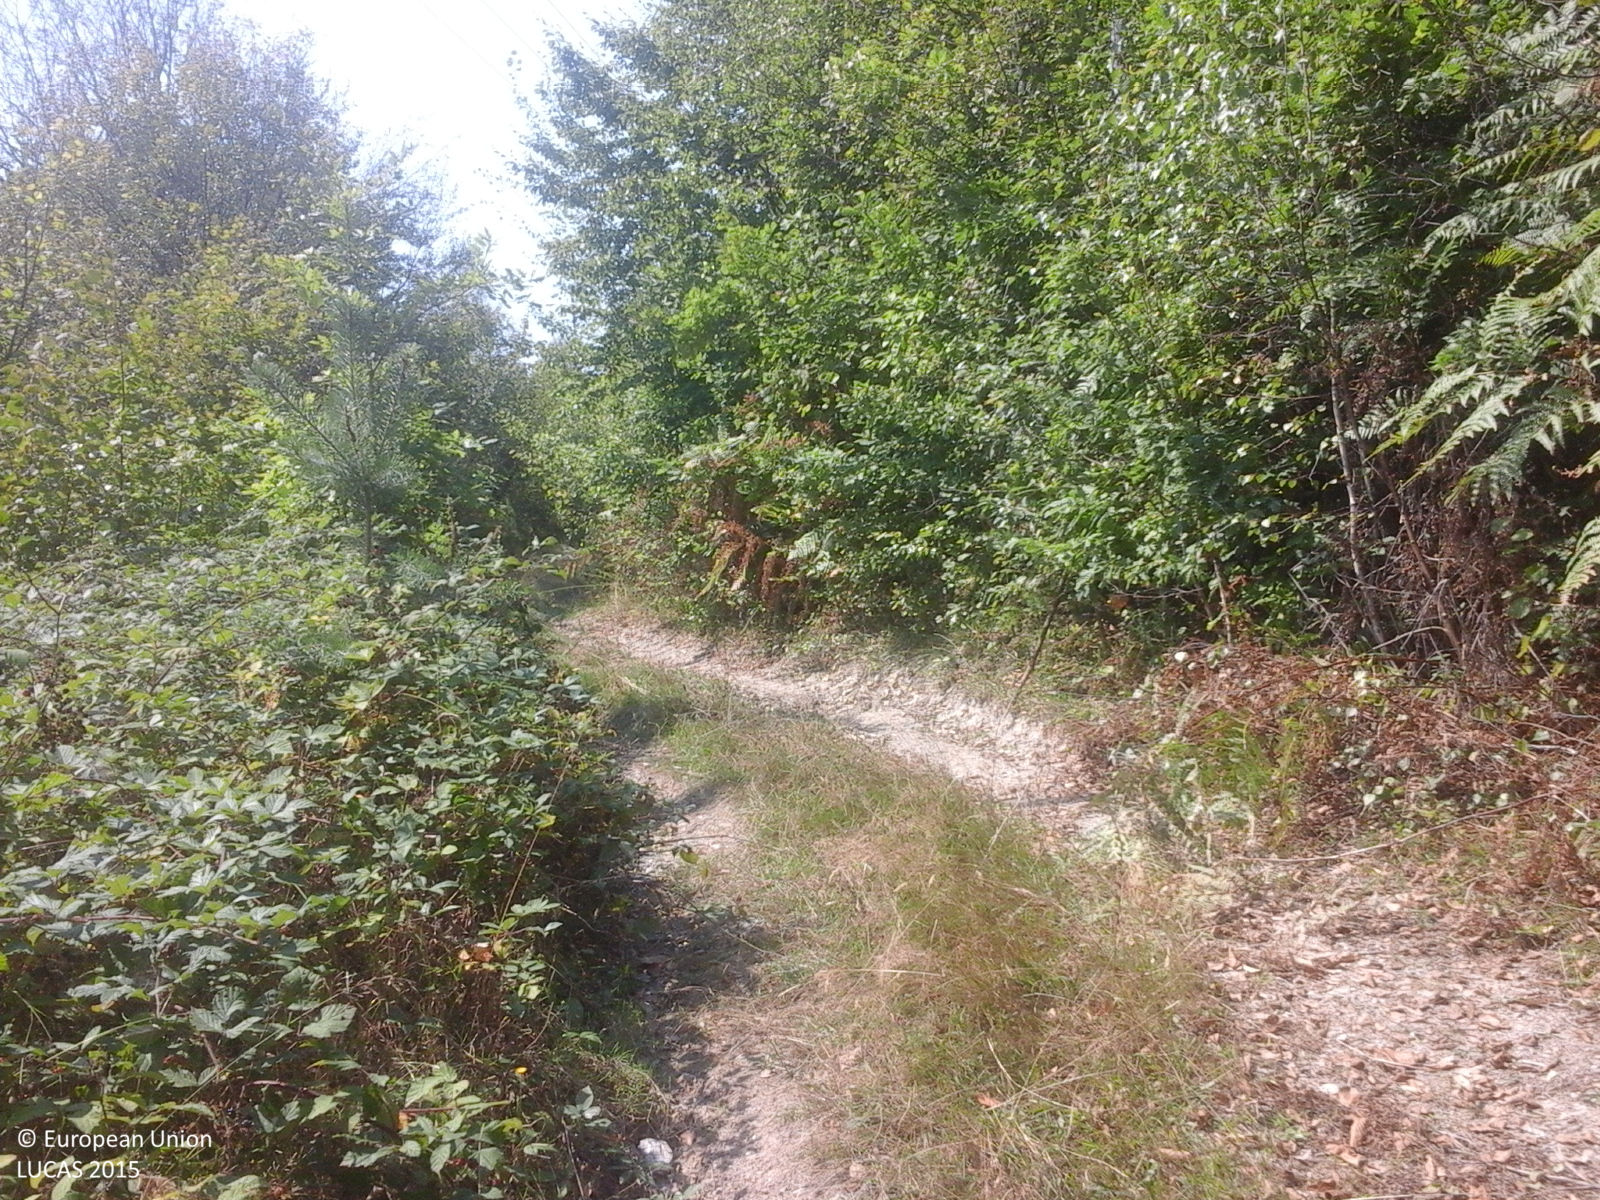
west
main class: Woodland
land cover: Broadleaved woodland
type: mesophytic deciduous forest
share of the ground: > 75 %
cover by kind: broadleaved forest trees 100 %
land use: Forestry
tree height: > 5 m
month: August
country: RO
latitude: 46.4068
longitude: 22.5789
